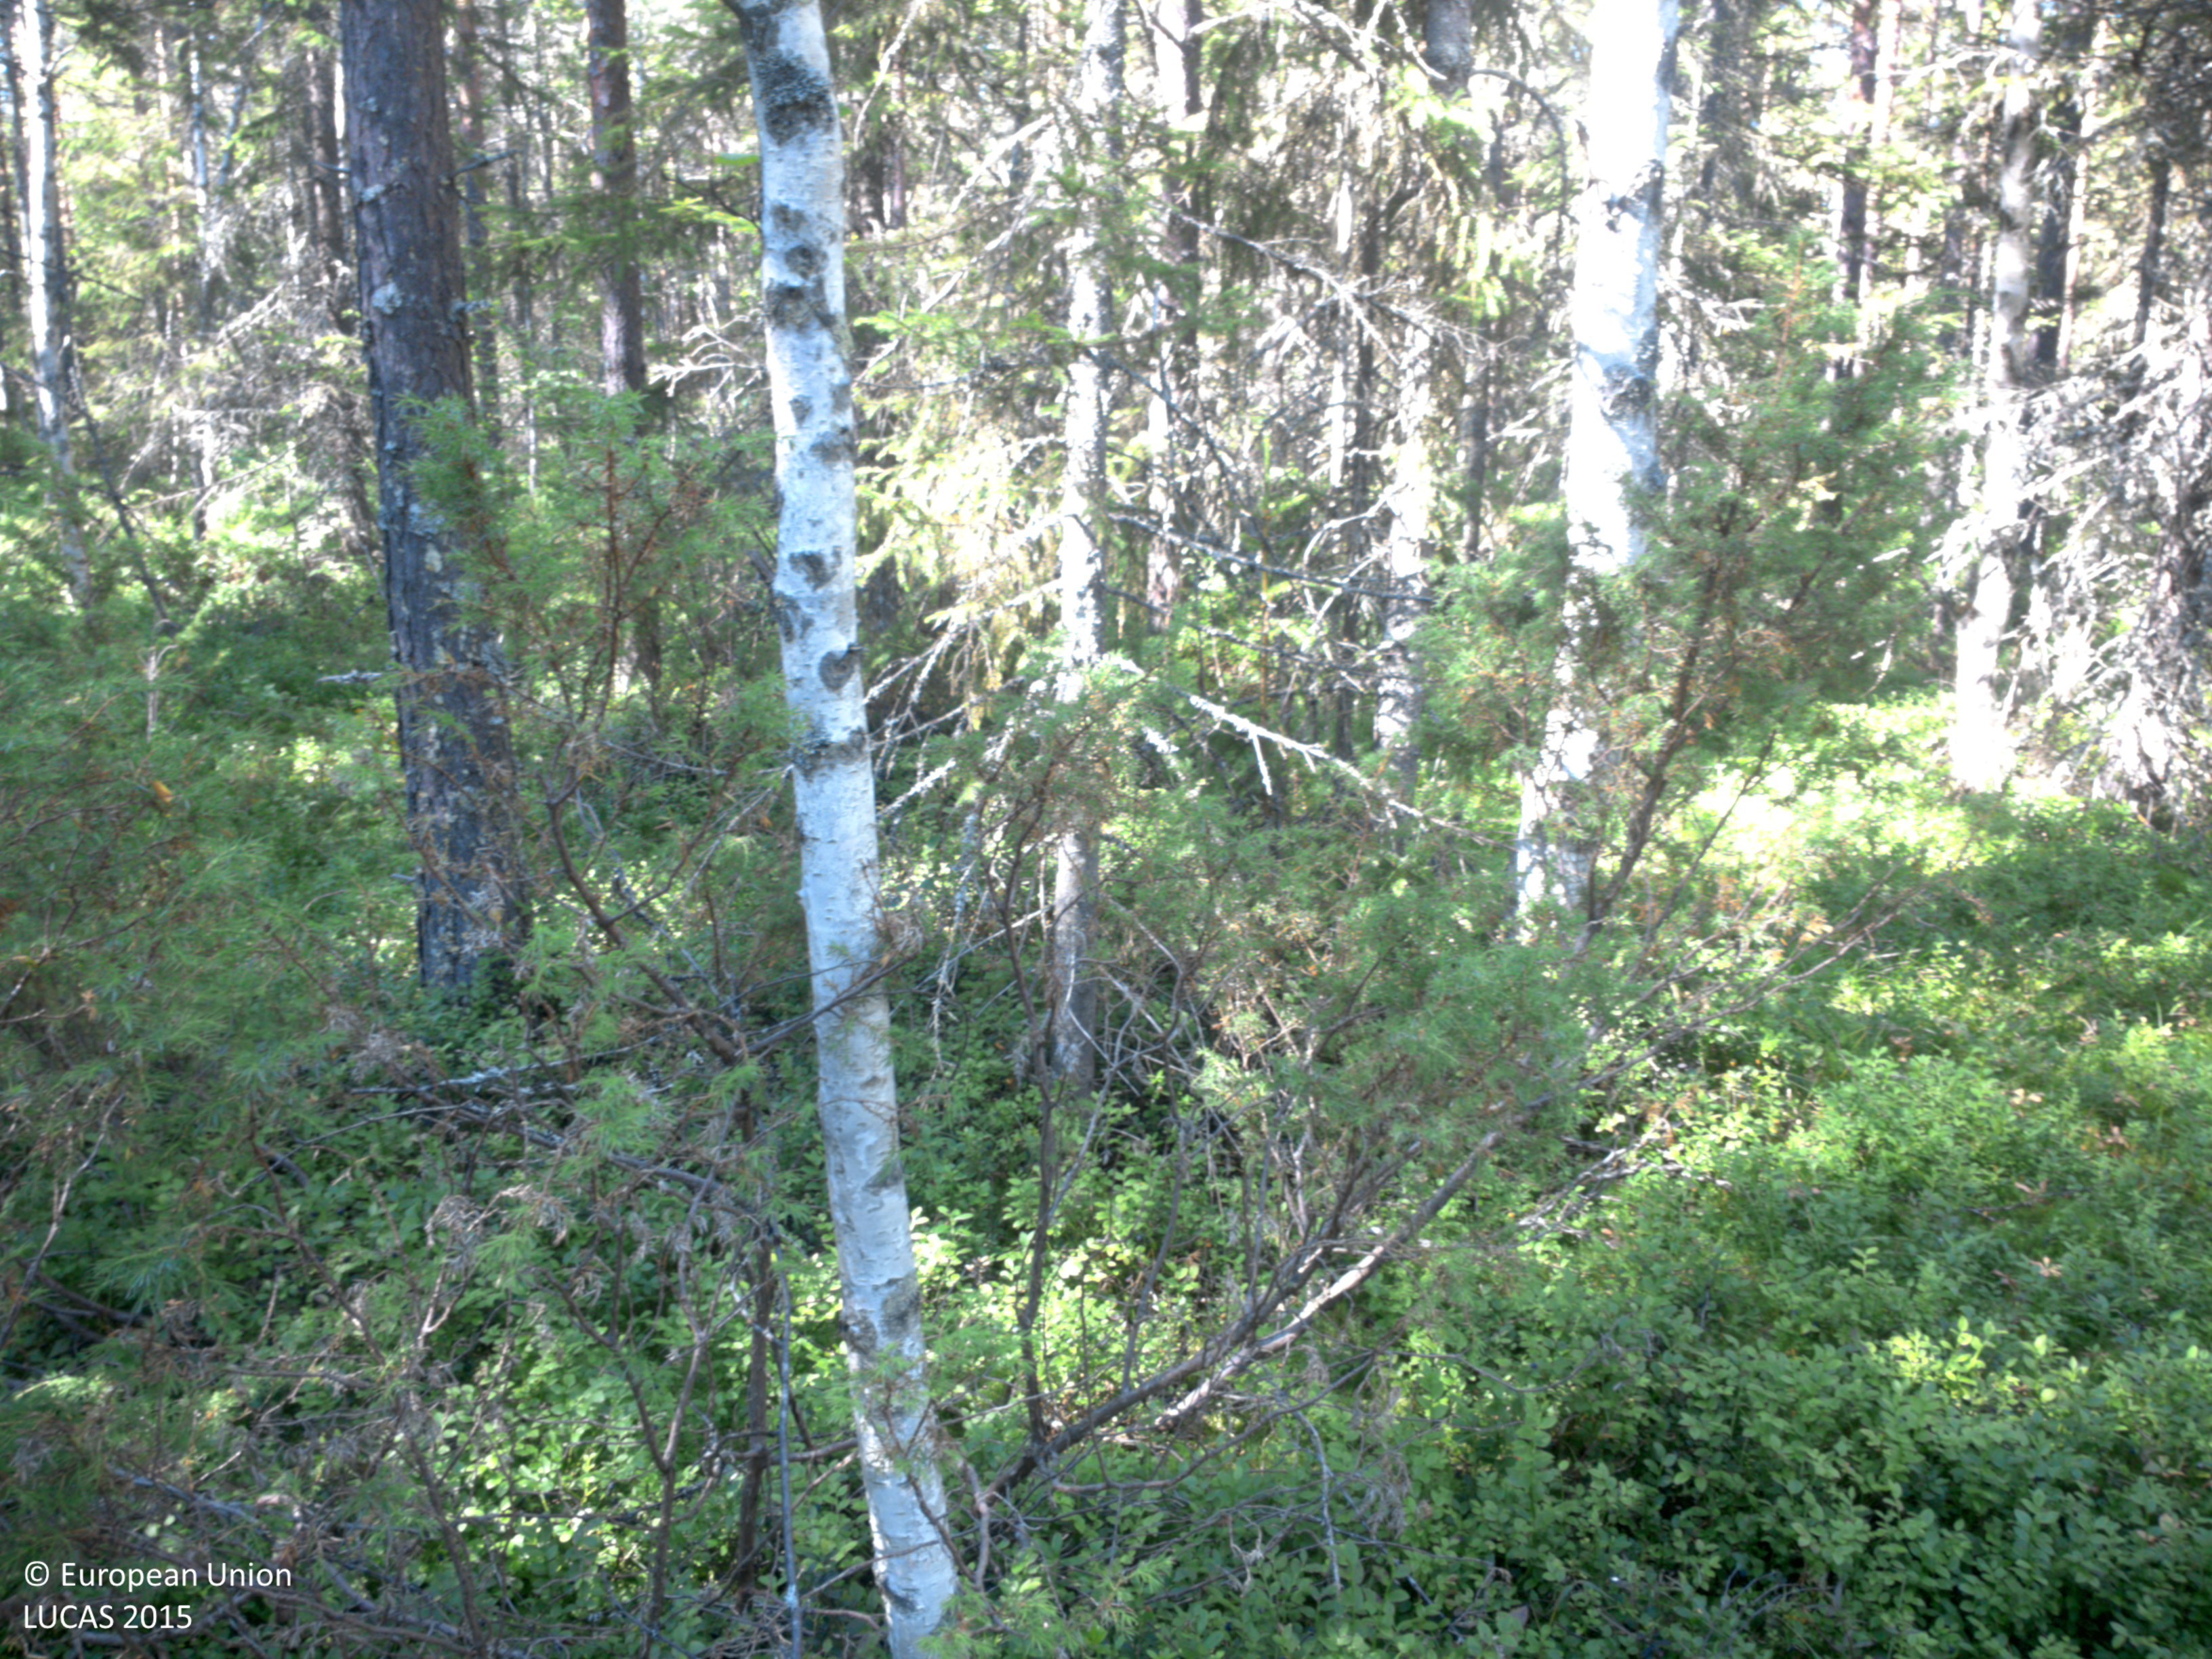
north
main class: Woodland
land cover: Other mixed woodland
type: boreal forest
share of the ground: 50 - 75 %
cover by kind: coniferous forest trees 40 %, shrubs 40 %, broadleaved forest trees 20 %
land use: Forestry
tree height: > 5 m
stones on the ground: < 10 %
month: August
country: SE
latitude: 63.6459
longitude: 19.6917
